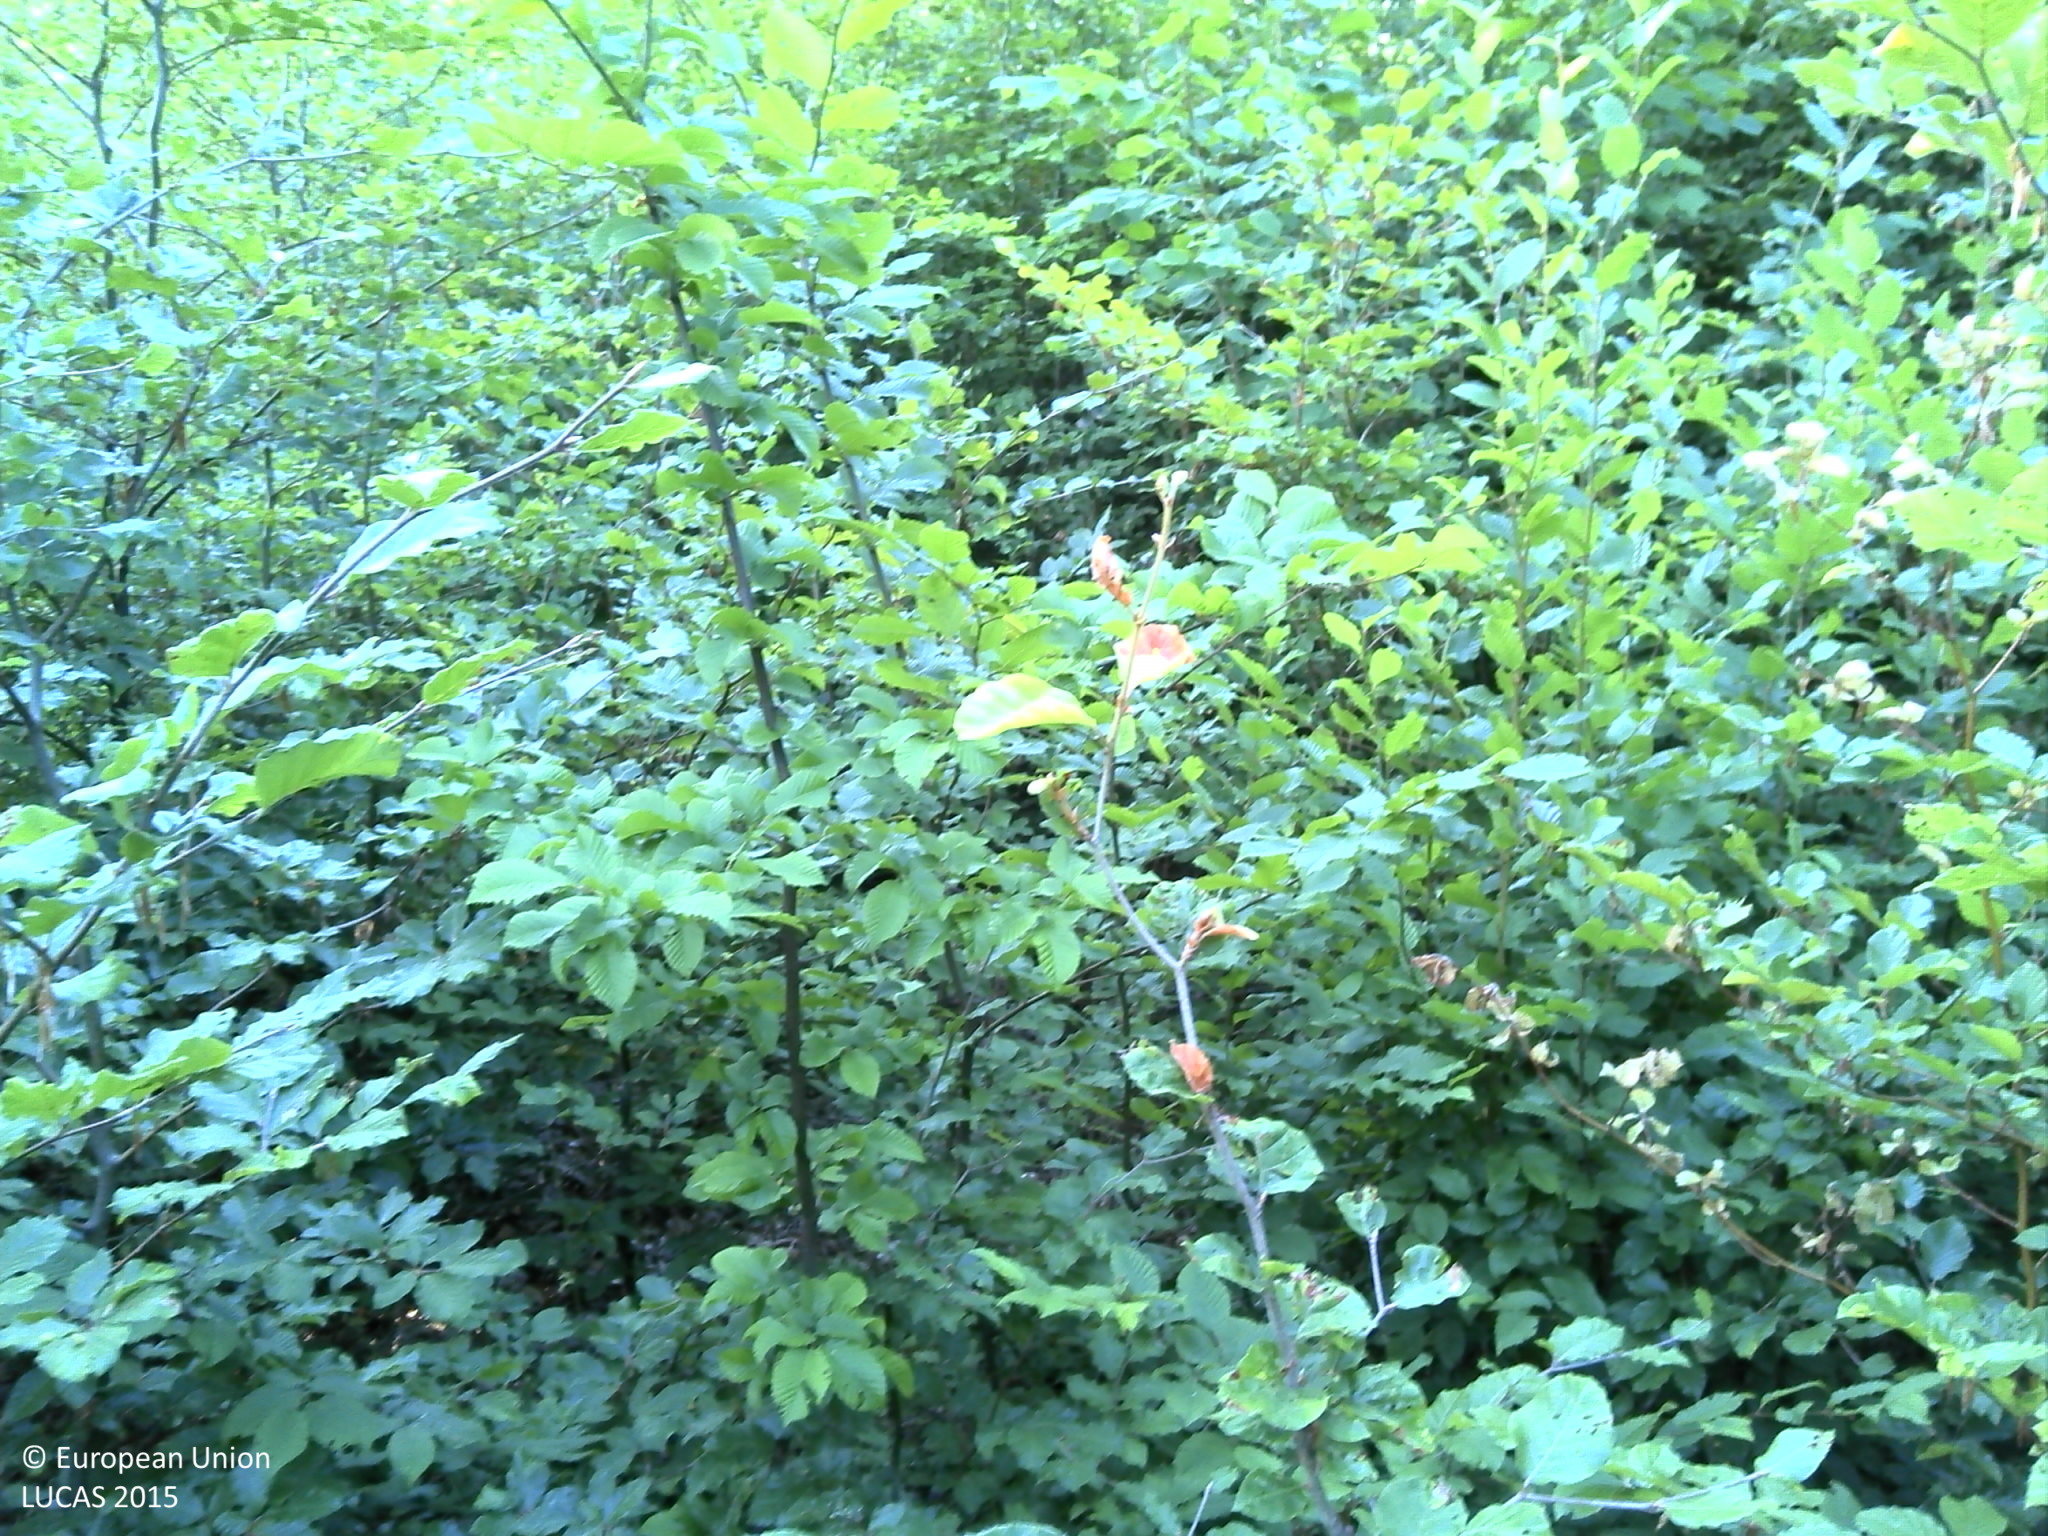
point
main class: Woodland
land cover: Broadleaved woodland
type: beech forest
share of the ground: > 75 %
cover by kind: broadleaved forest trees 100 %
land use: Forestry
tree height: > 5 m
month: July
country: FR
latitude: 48.1436
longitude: 6.3047
